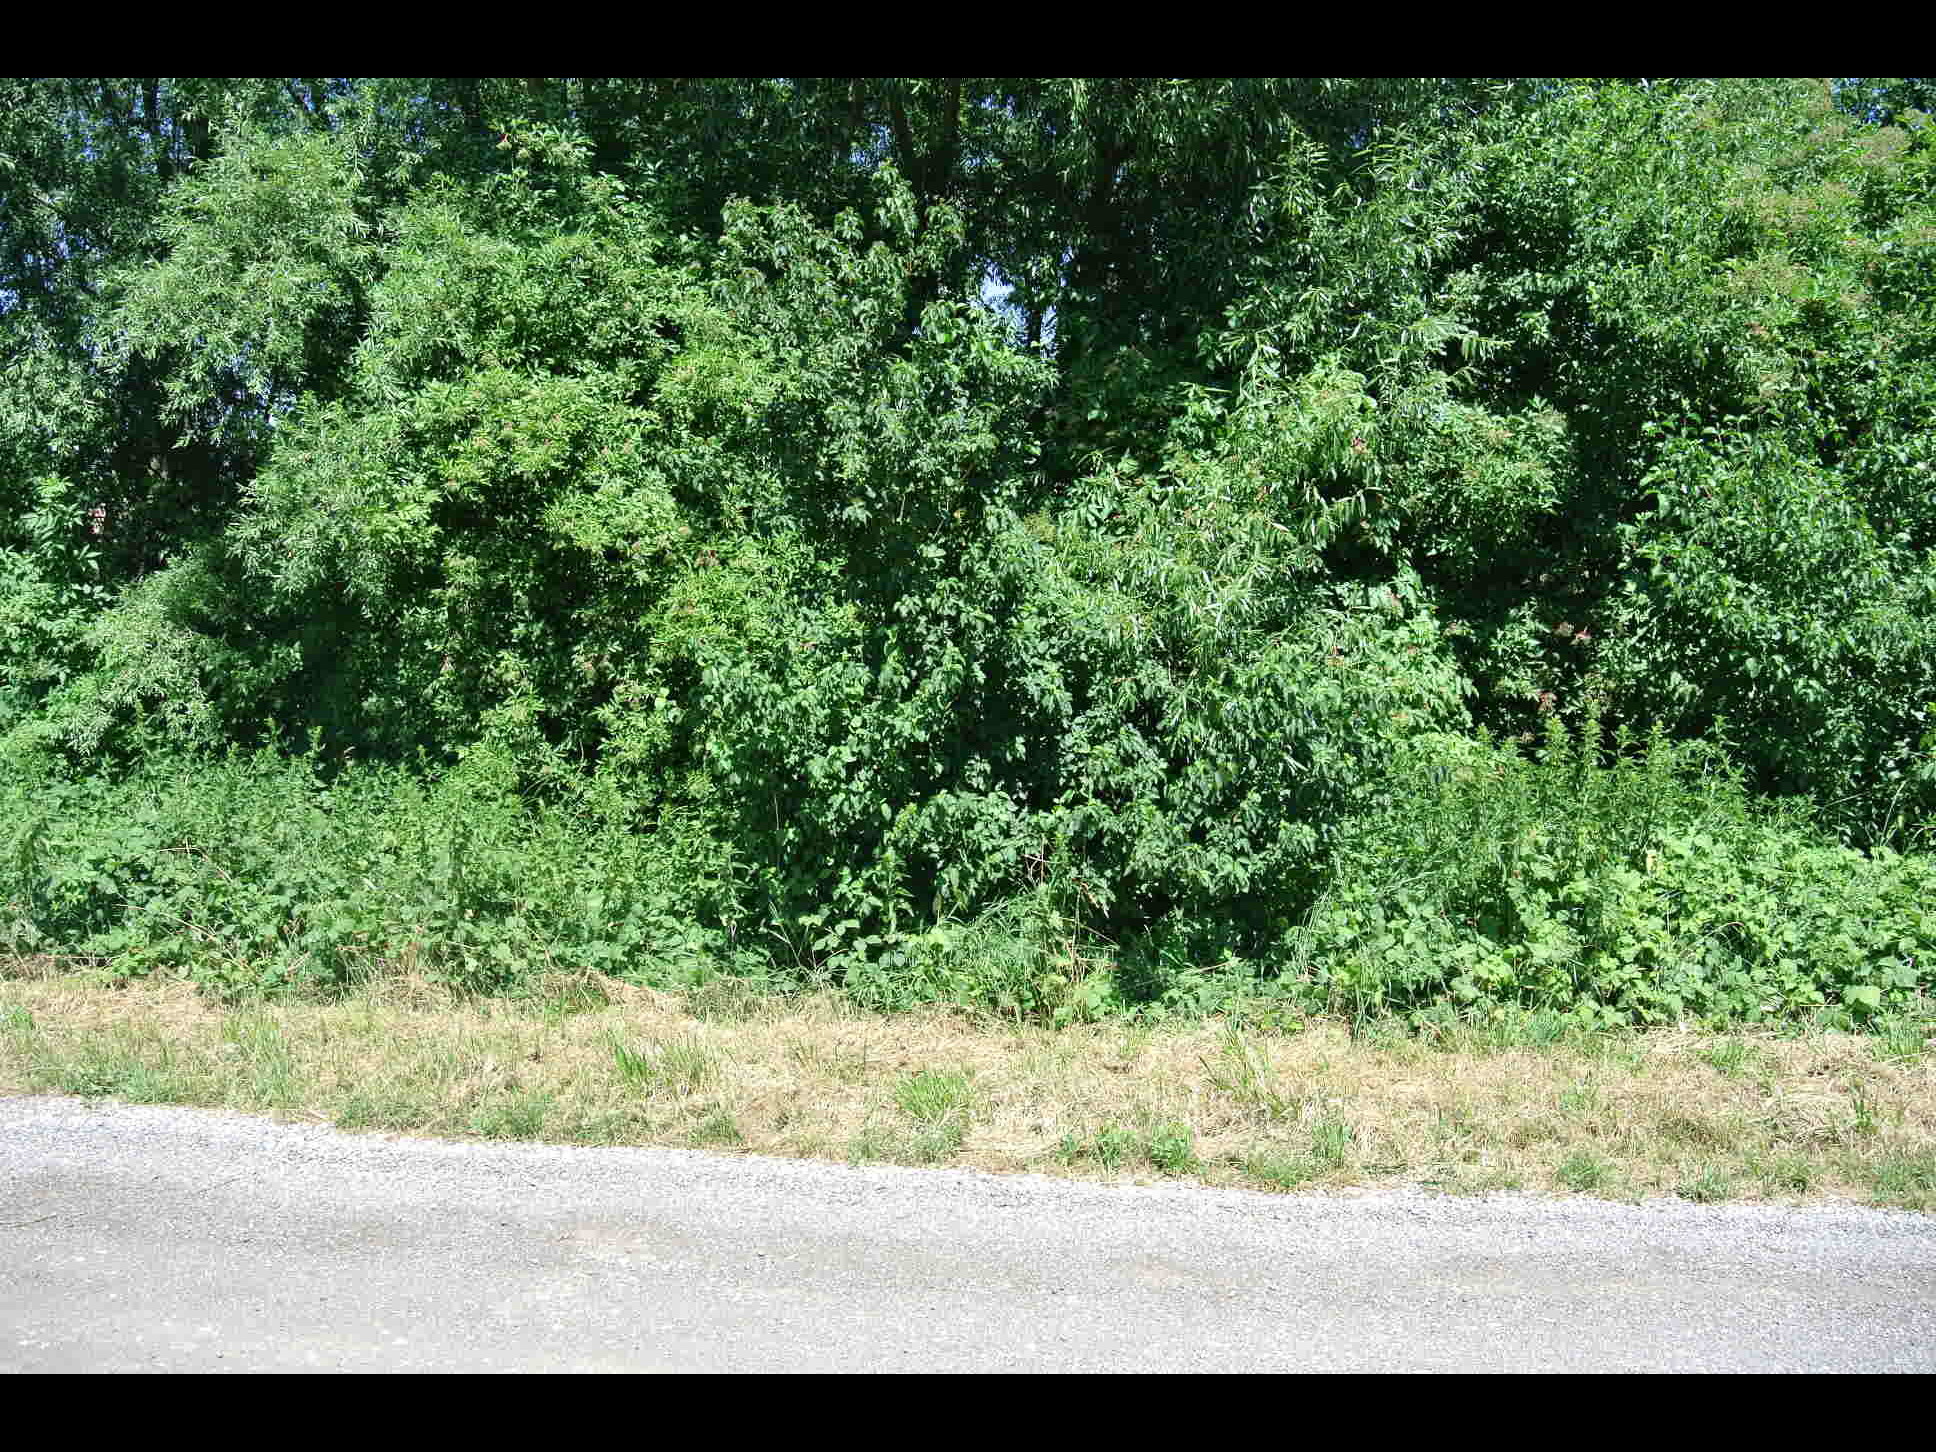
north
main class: Cropland
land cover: Durum wheat
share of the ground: > 75 %
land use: Agriculture (excluding fallow land and kitchen gardens)
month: July
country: AT
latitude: 47.7102
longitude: 16.4417
